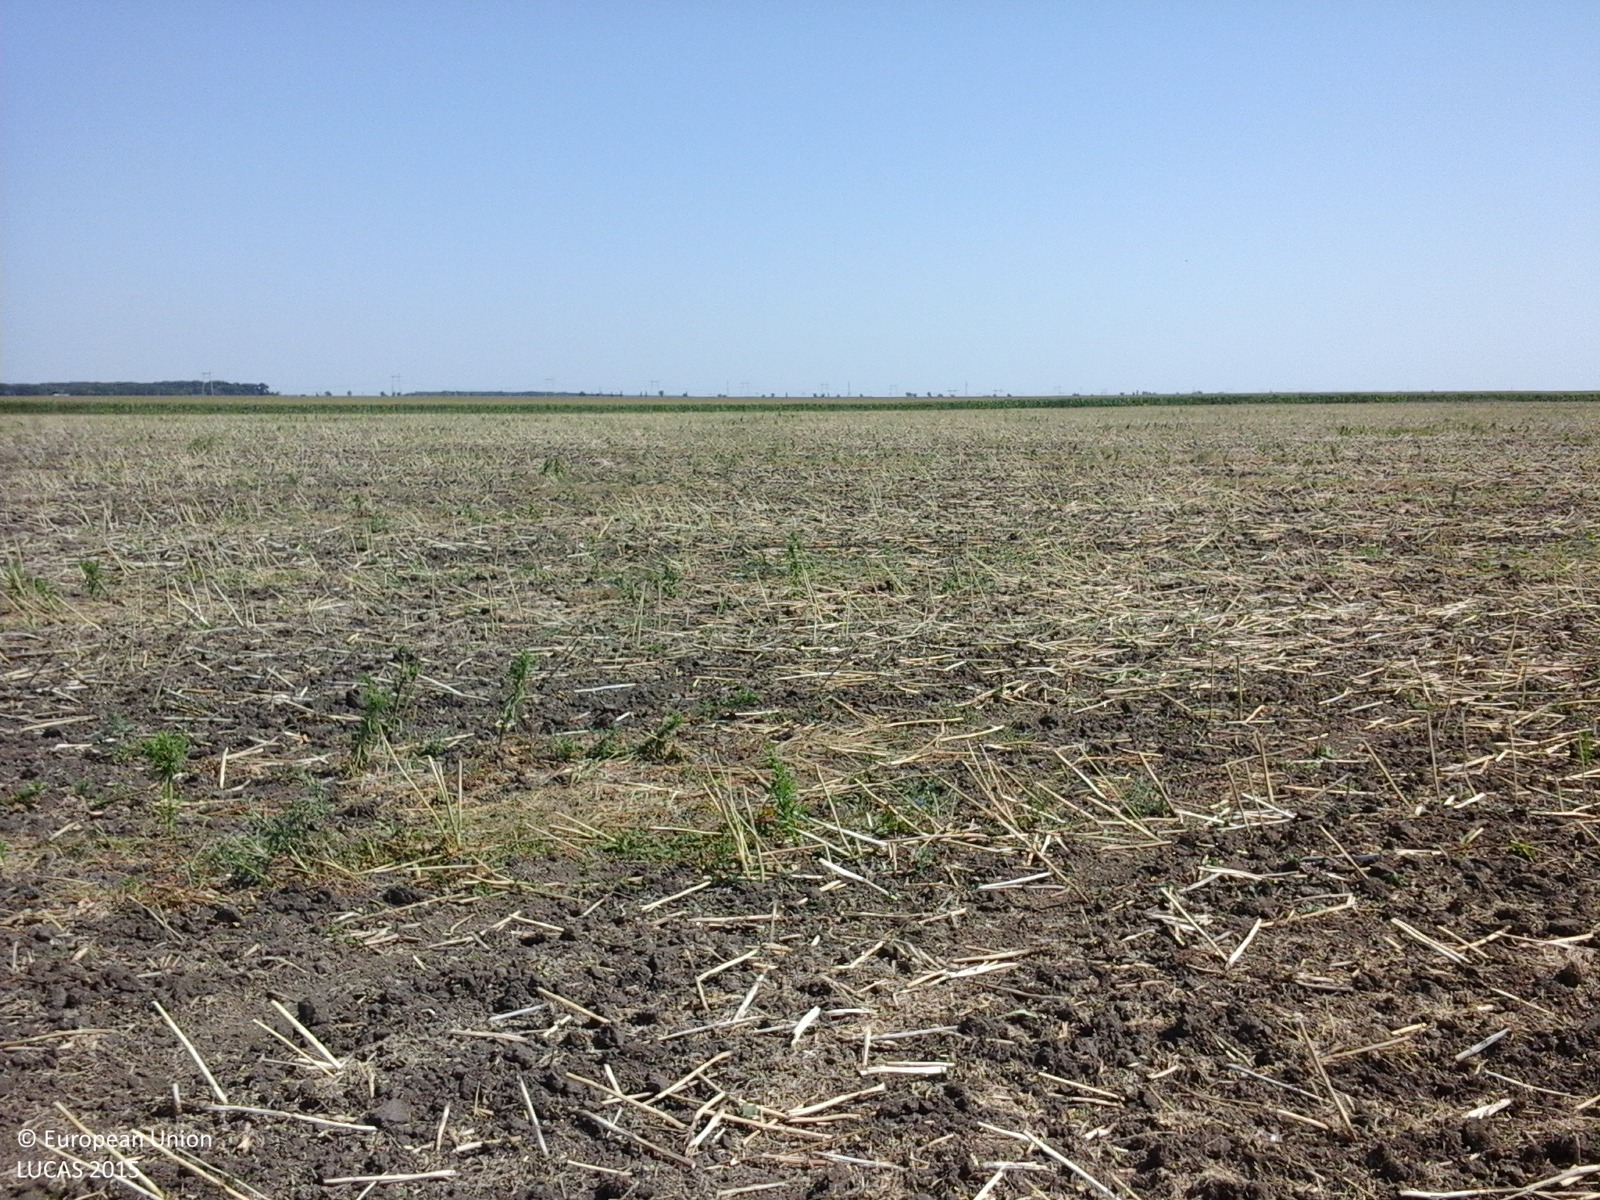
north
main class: Cropland
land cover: Rape and turnip rape
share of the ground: < 10 %
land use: Agriculture (excluding fallow land and kitchen gardens)
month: July
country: RO
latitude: 44.4402
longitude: 26.4600
